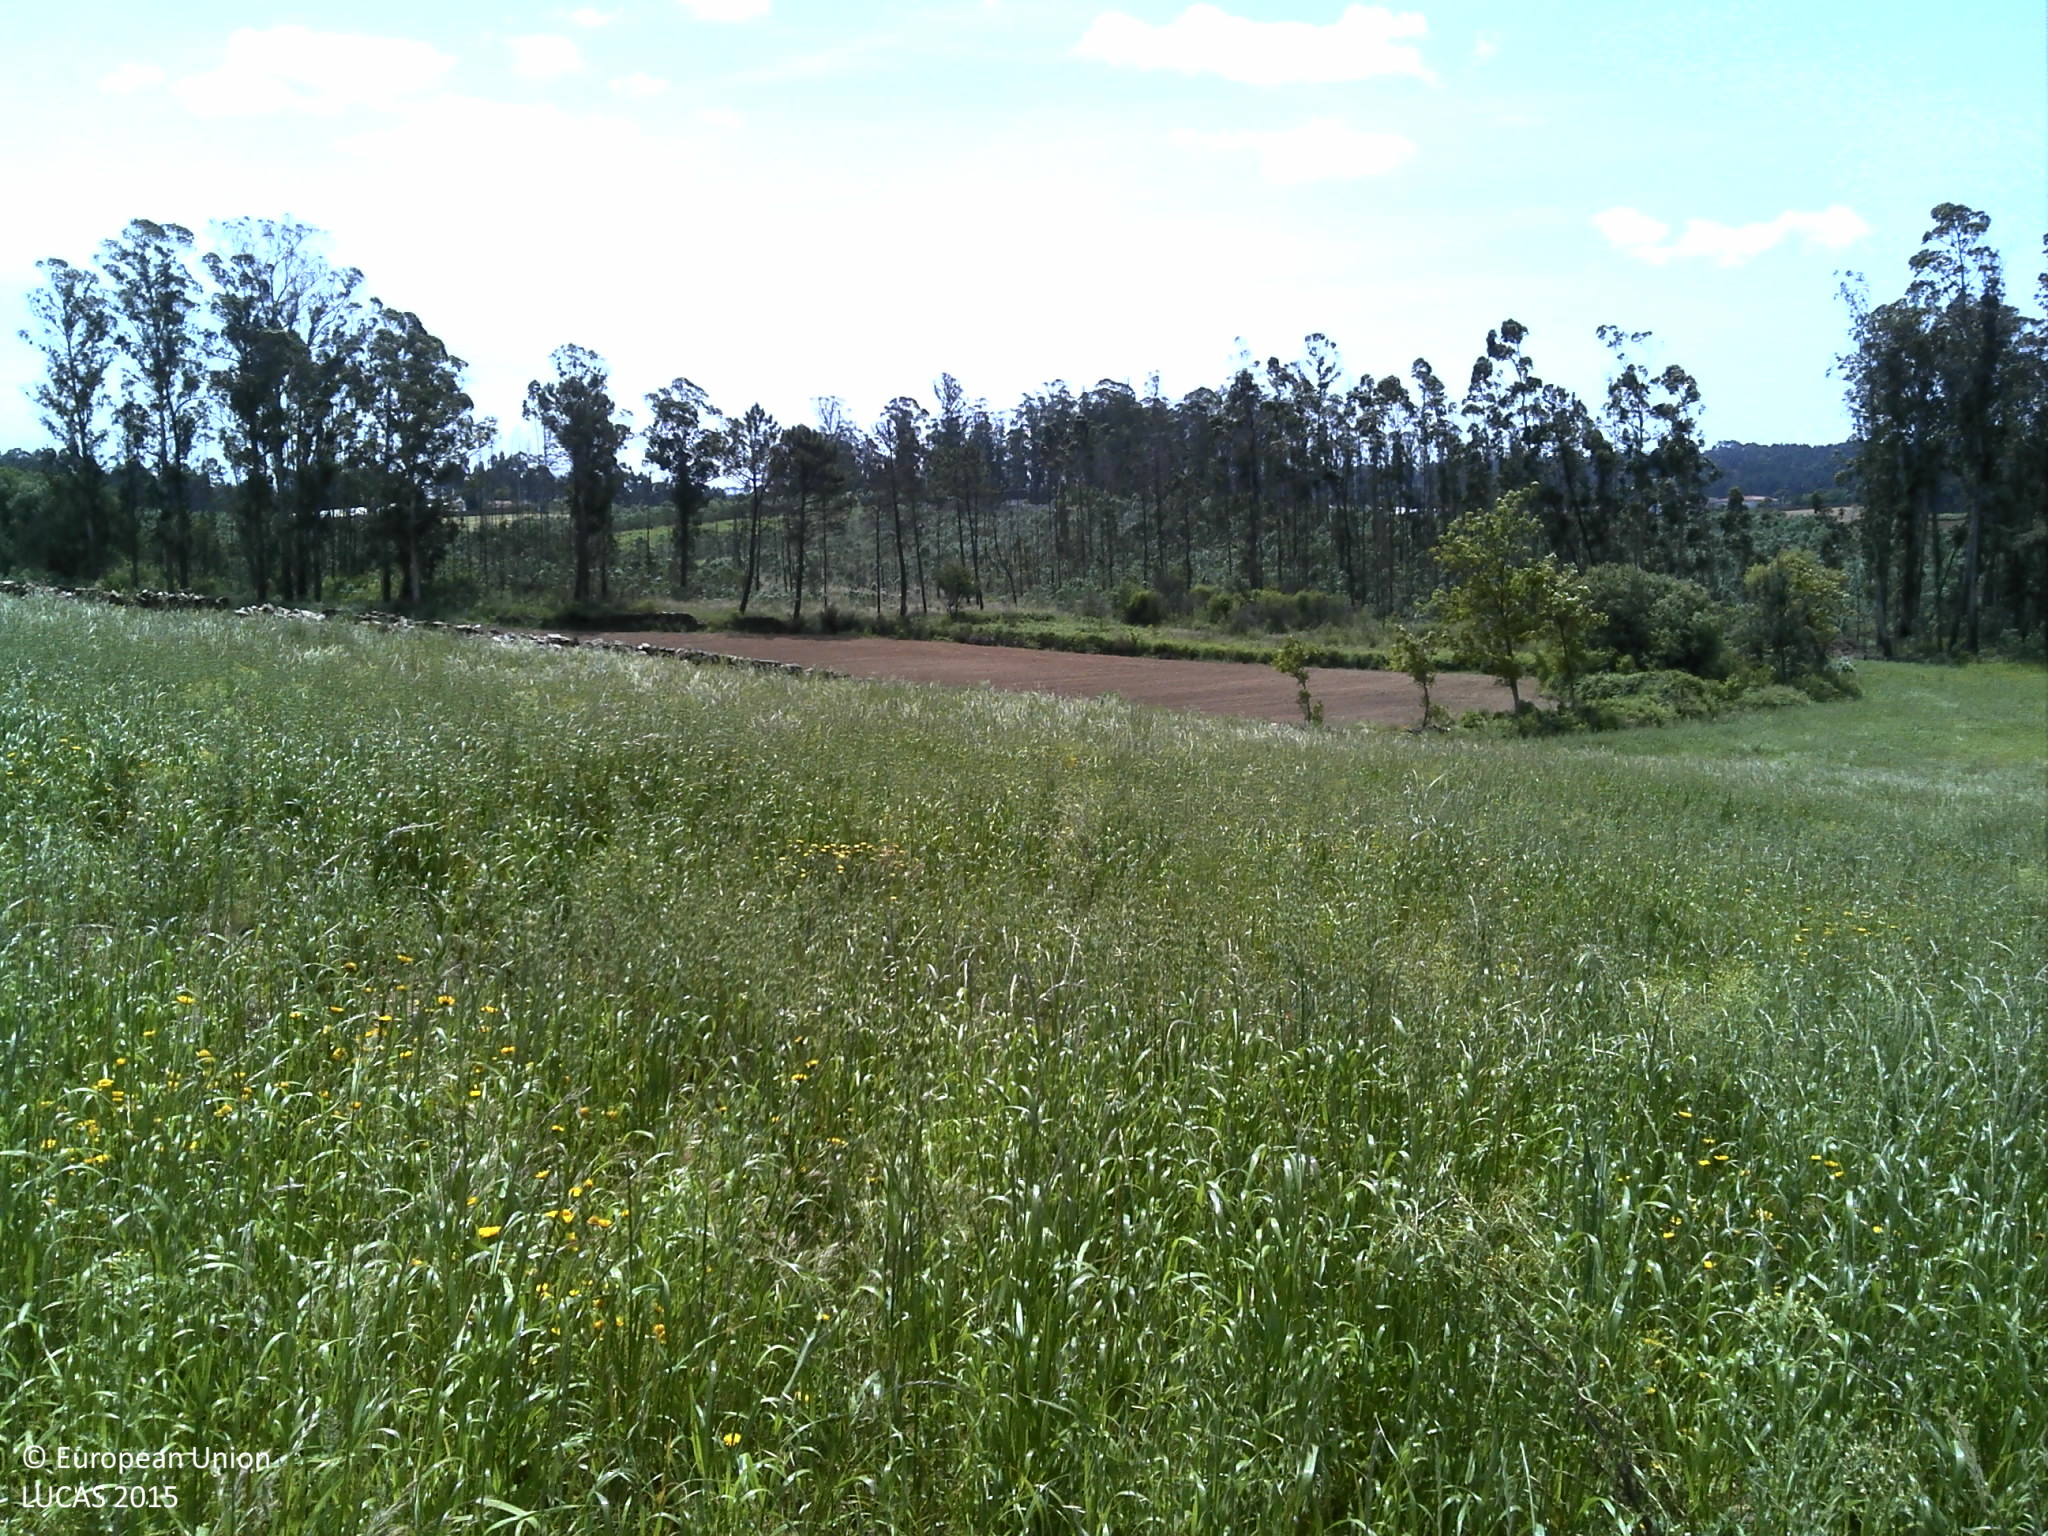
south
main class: Cropland
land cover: Mixed cereals for fodder
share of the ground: > 75 %
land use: Agriculture (excluding fallow land and kitchen gardens)
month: May
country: PT
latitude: 41.4483
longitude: -8.7019
